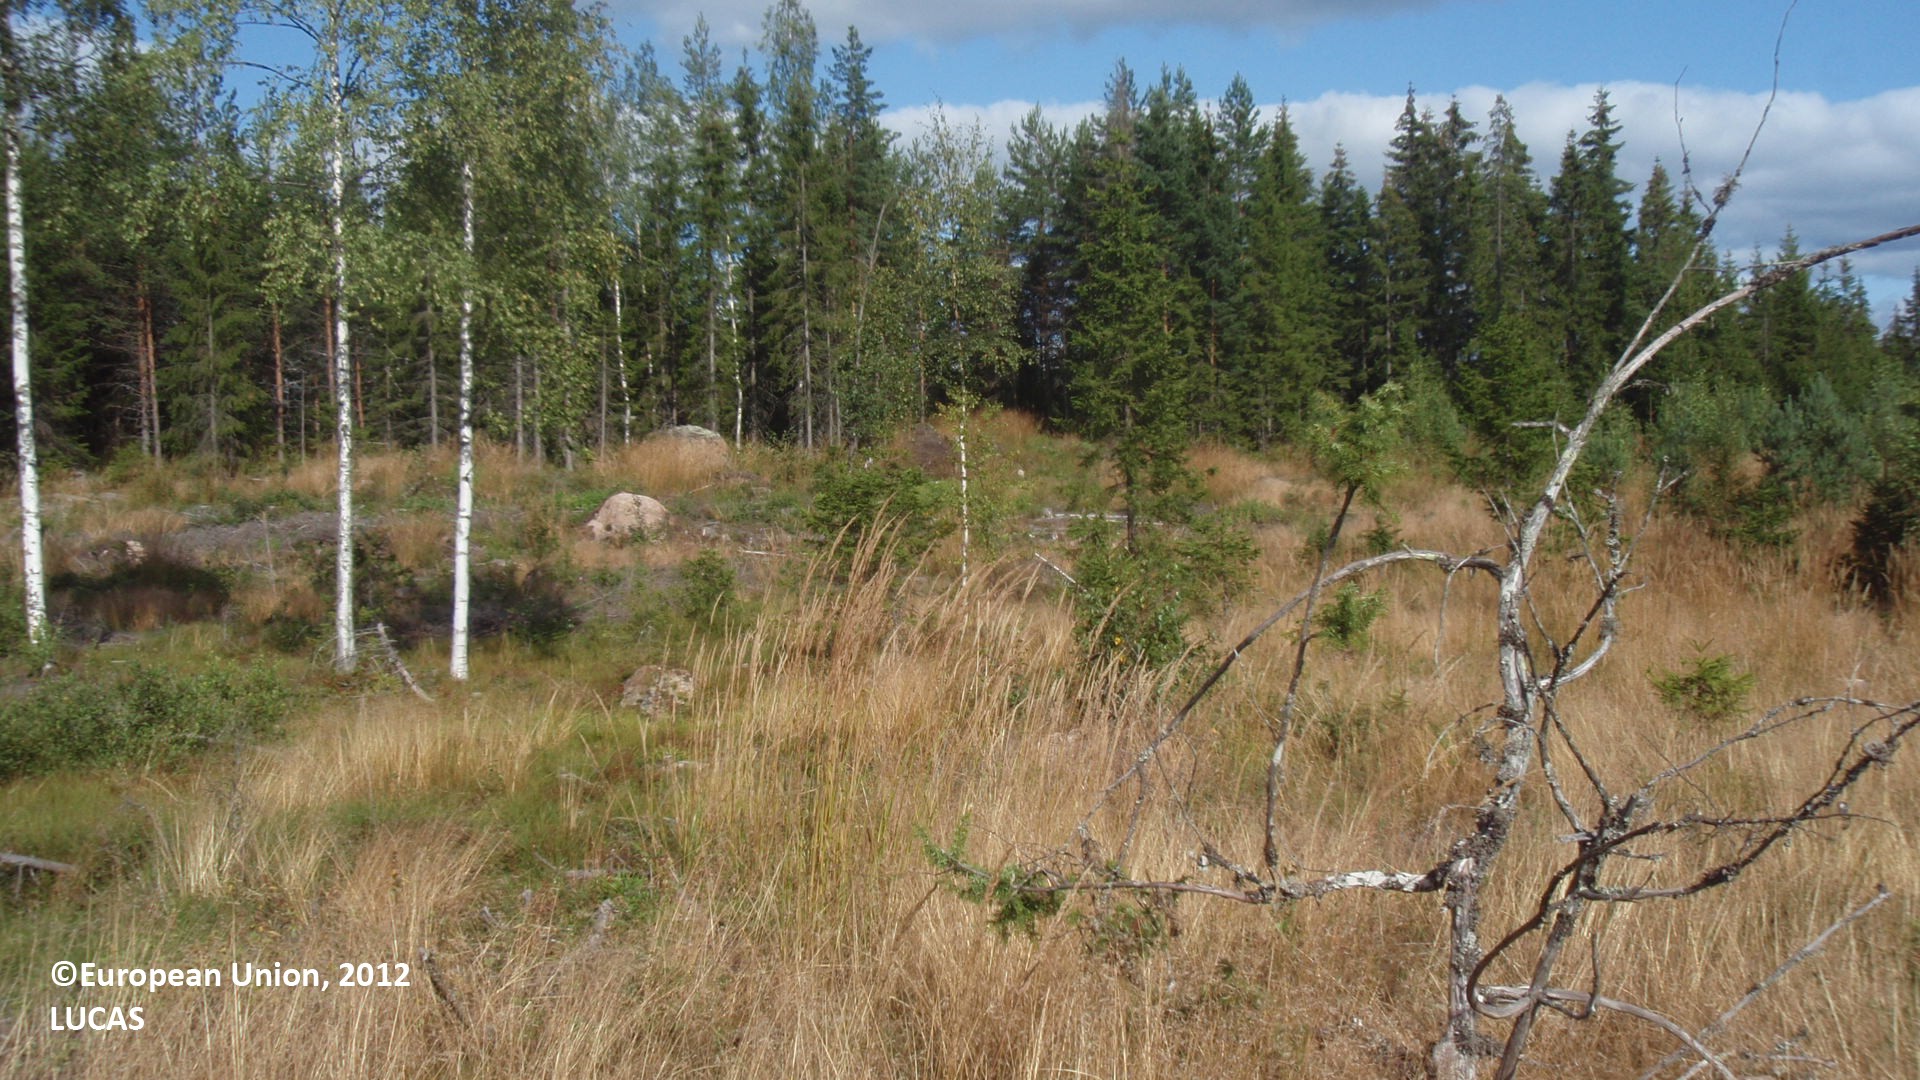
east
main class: Grassland
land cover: Grassland with sparse tree/shrub cover
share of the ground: 50 - 75 %
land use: Forestry
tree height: > 5 m
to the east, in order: Grassland with sparse tree/shrub cover; Pine dominated mixed woodland; Spruce dominated coniferous woodland
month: August
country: FI
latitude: 60.7246
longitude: 27.4712
